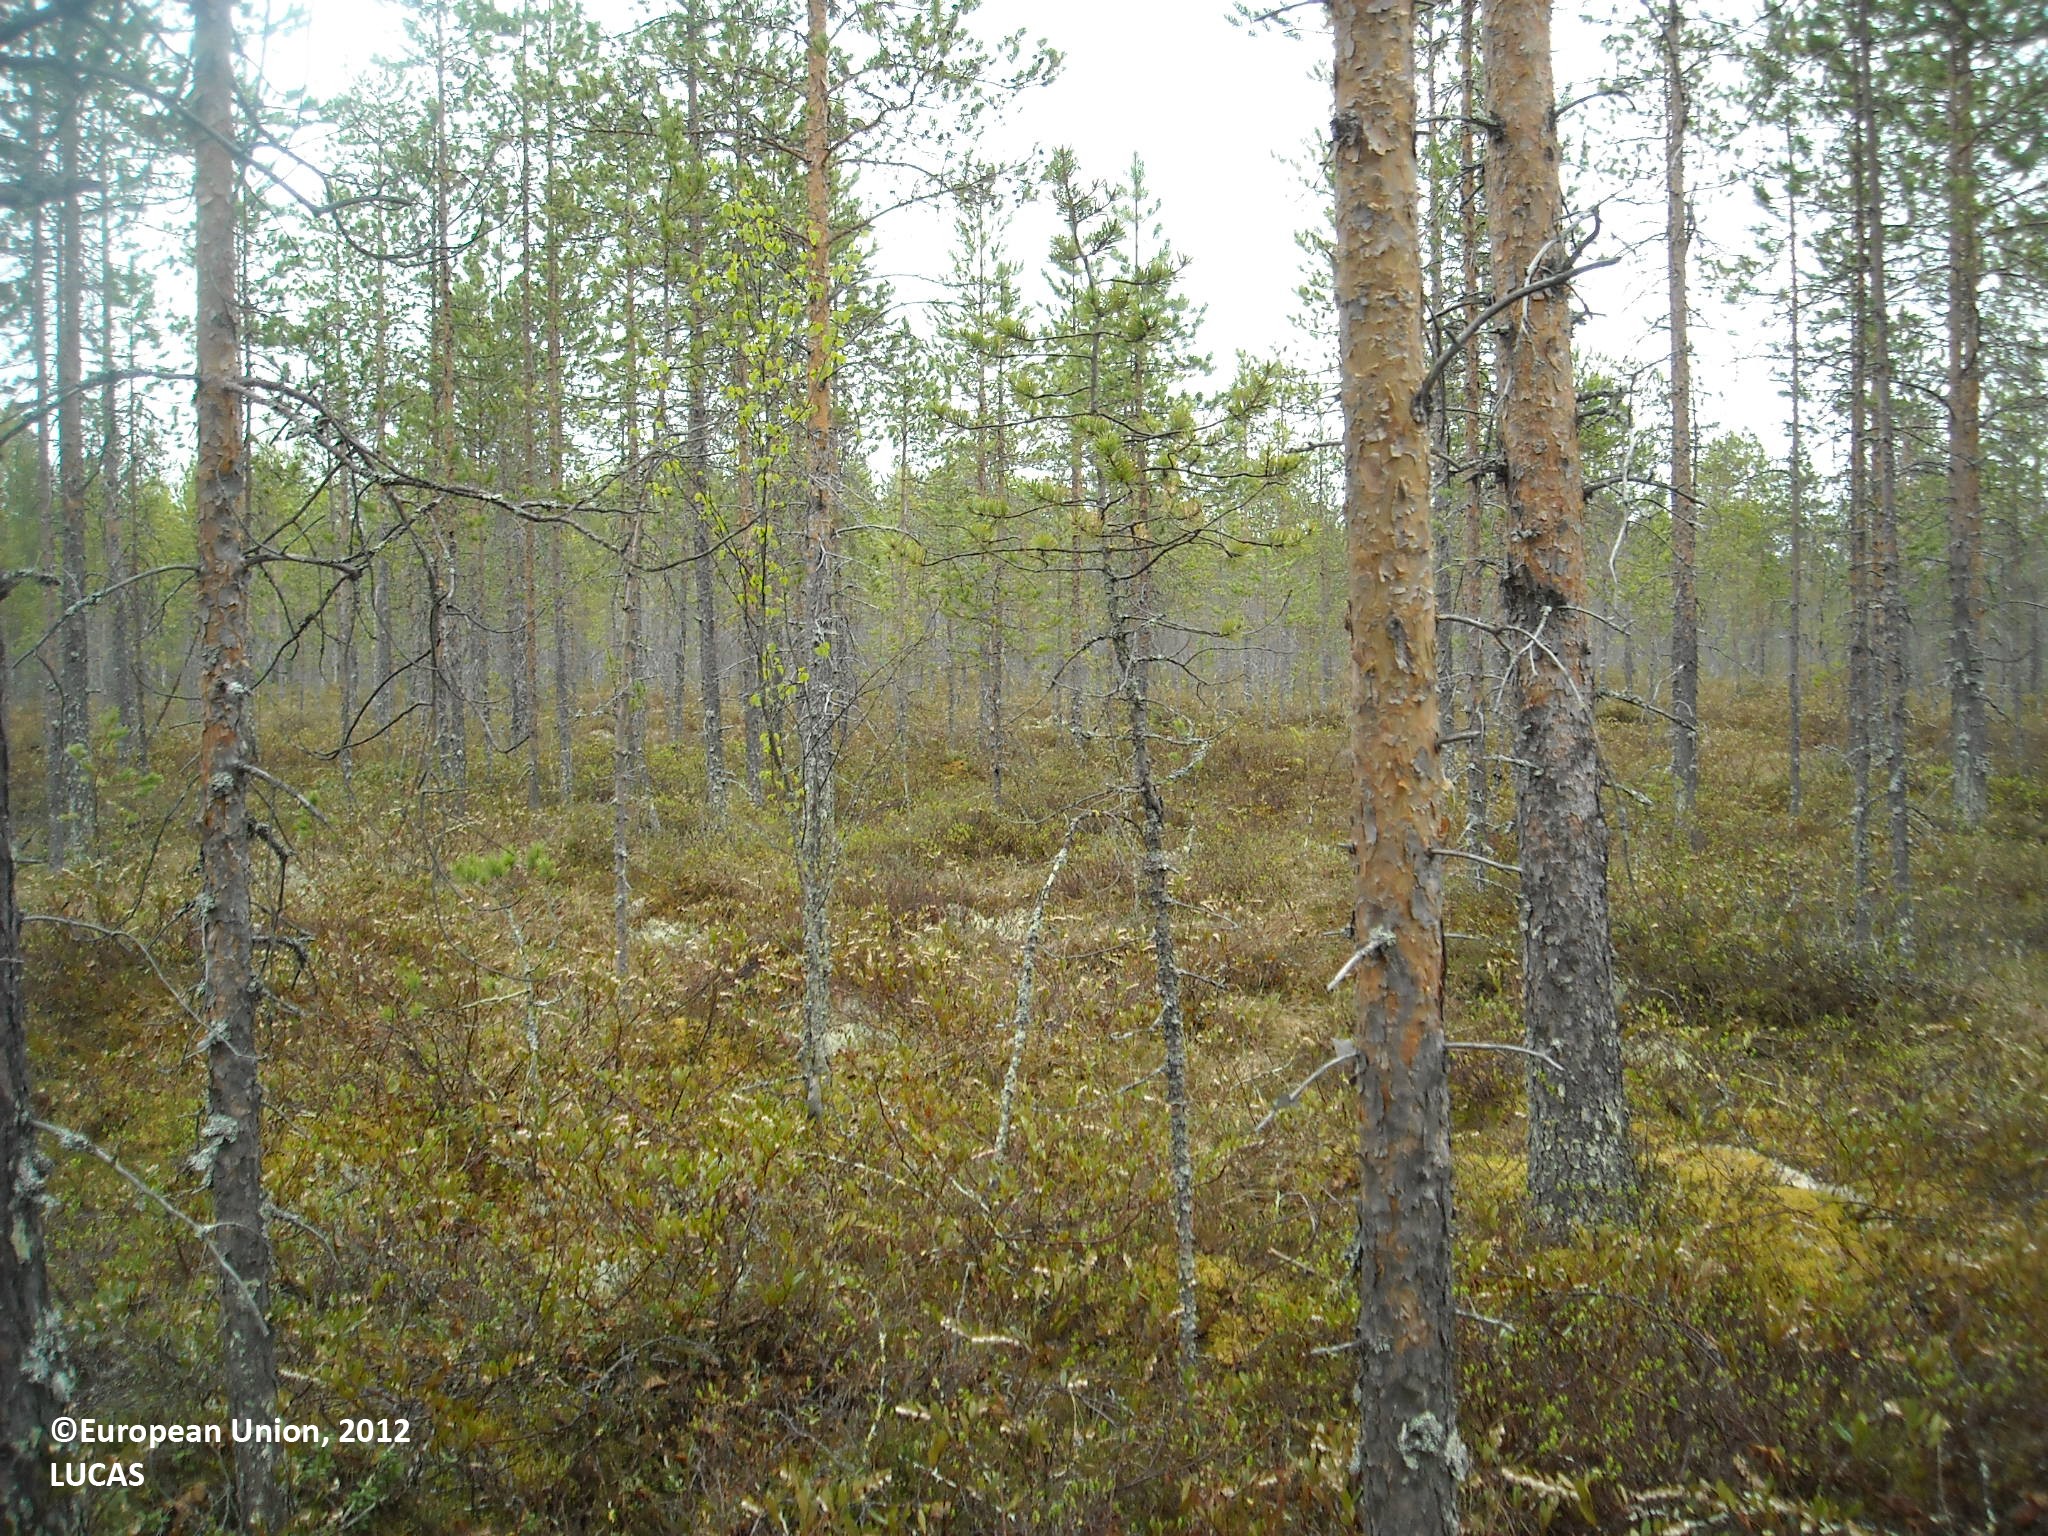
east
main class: Woodland
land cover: Pine dominated coniferous woodland
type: mire and swamp forests
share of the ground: > 75 %
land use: Forestry
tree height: > 5 m
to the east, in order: Pine dominated coniferous woodland; Pine dominated mixed woodland; Ditches and canals; Pine dominated mixed woodland; Pine dominated coniferous woodland; Ditches and canals; Pine dominated coniferous woodland; Pine dominated mixed woodland
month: June
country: FI
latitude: 64.5999
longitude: 27.2039
